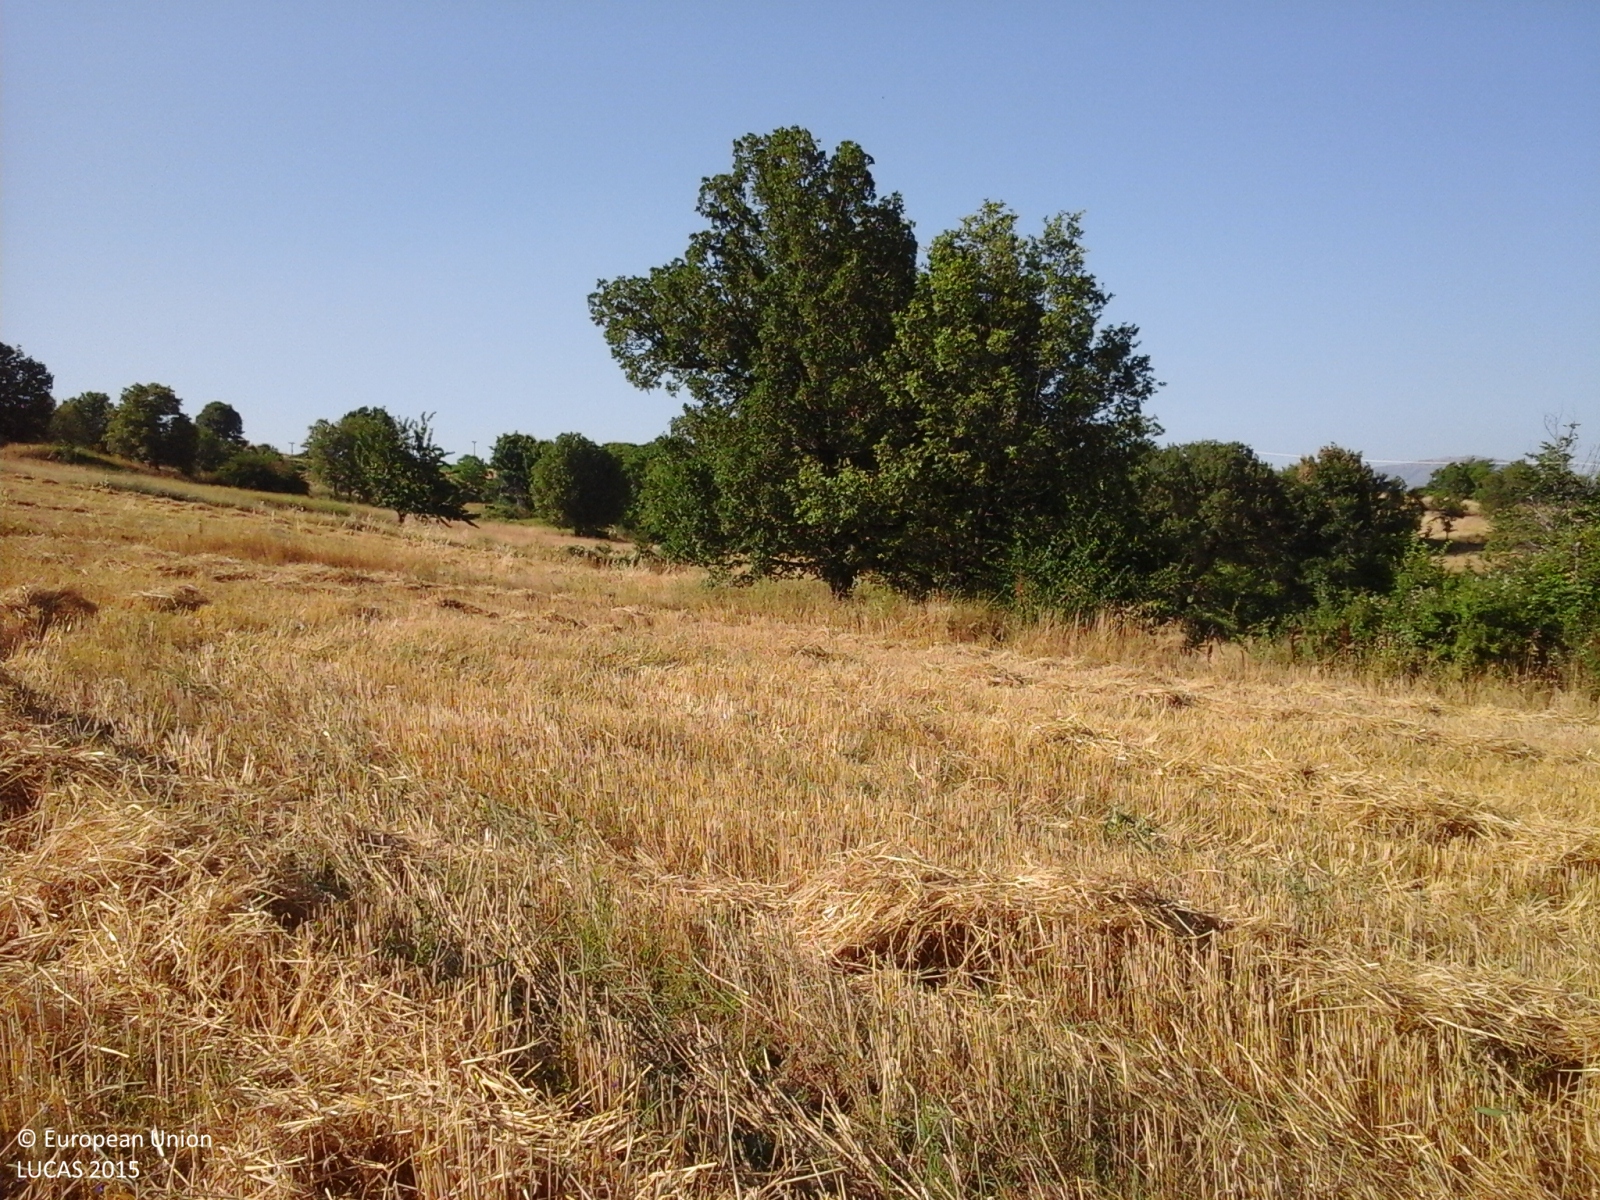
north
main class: Cropland
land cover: Barley
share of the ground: > 75 %
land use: Agriculture (excluding fallow land and kitchen gardens)
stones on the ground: < 10 %
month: July
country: GR
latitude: 40.3215
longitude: 21.3216
